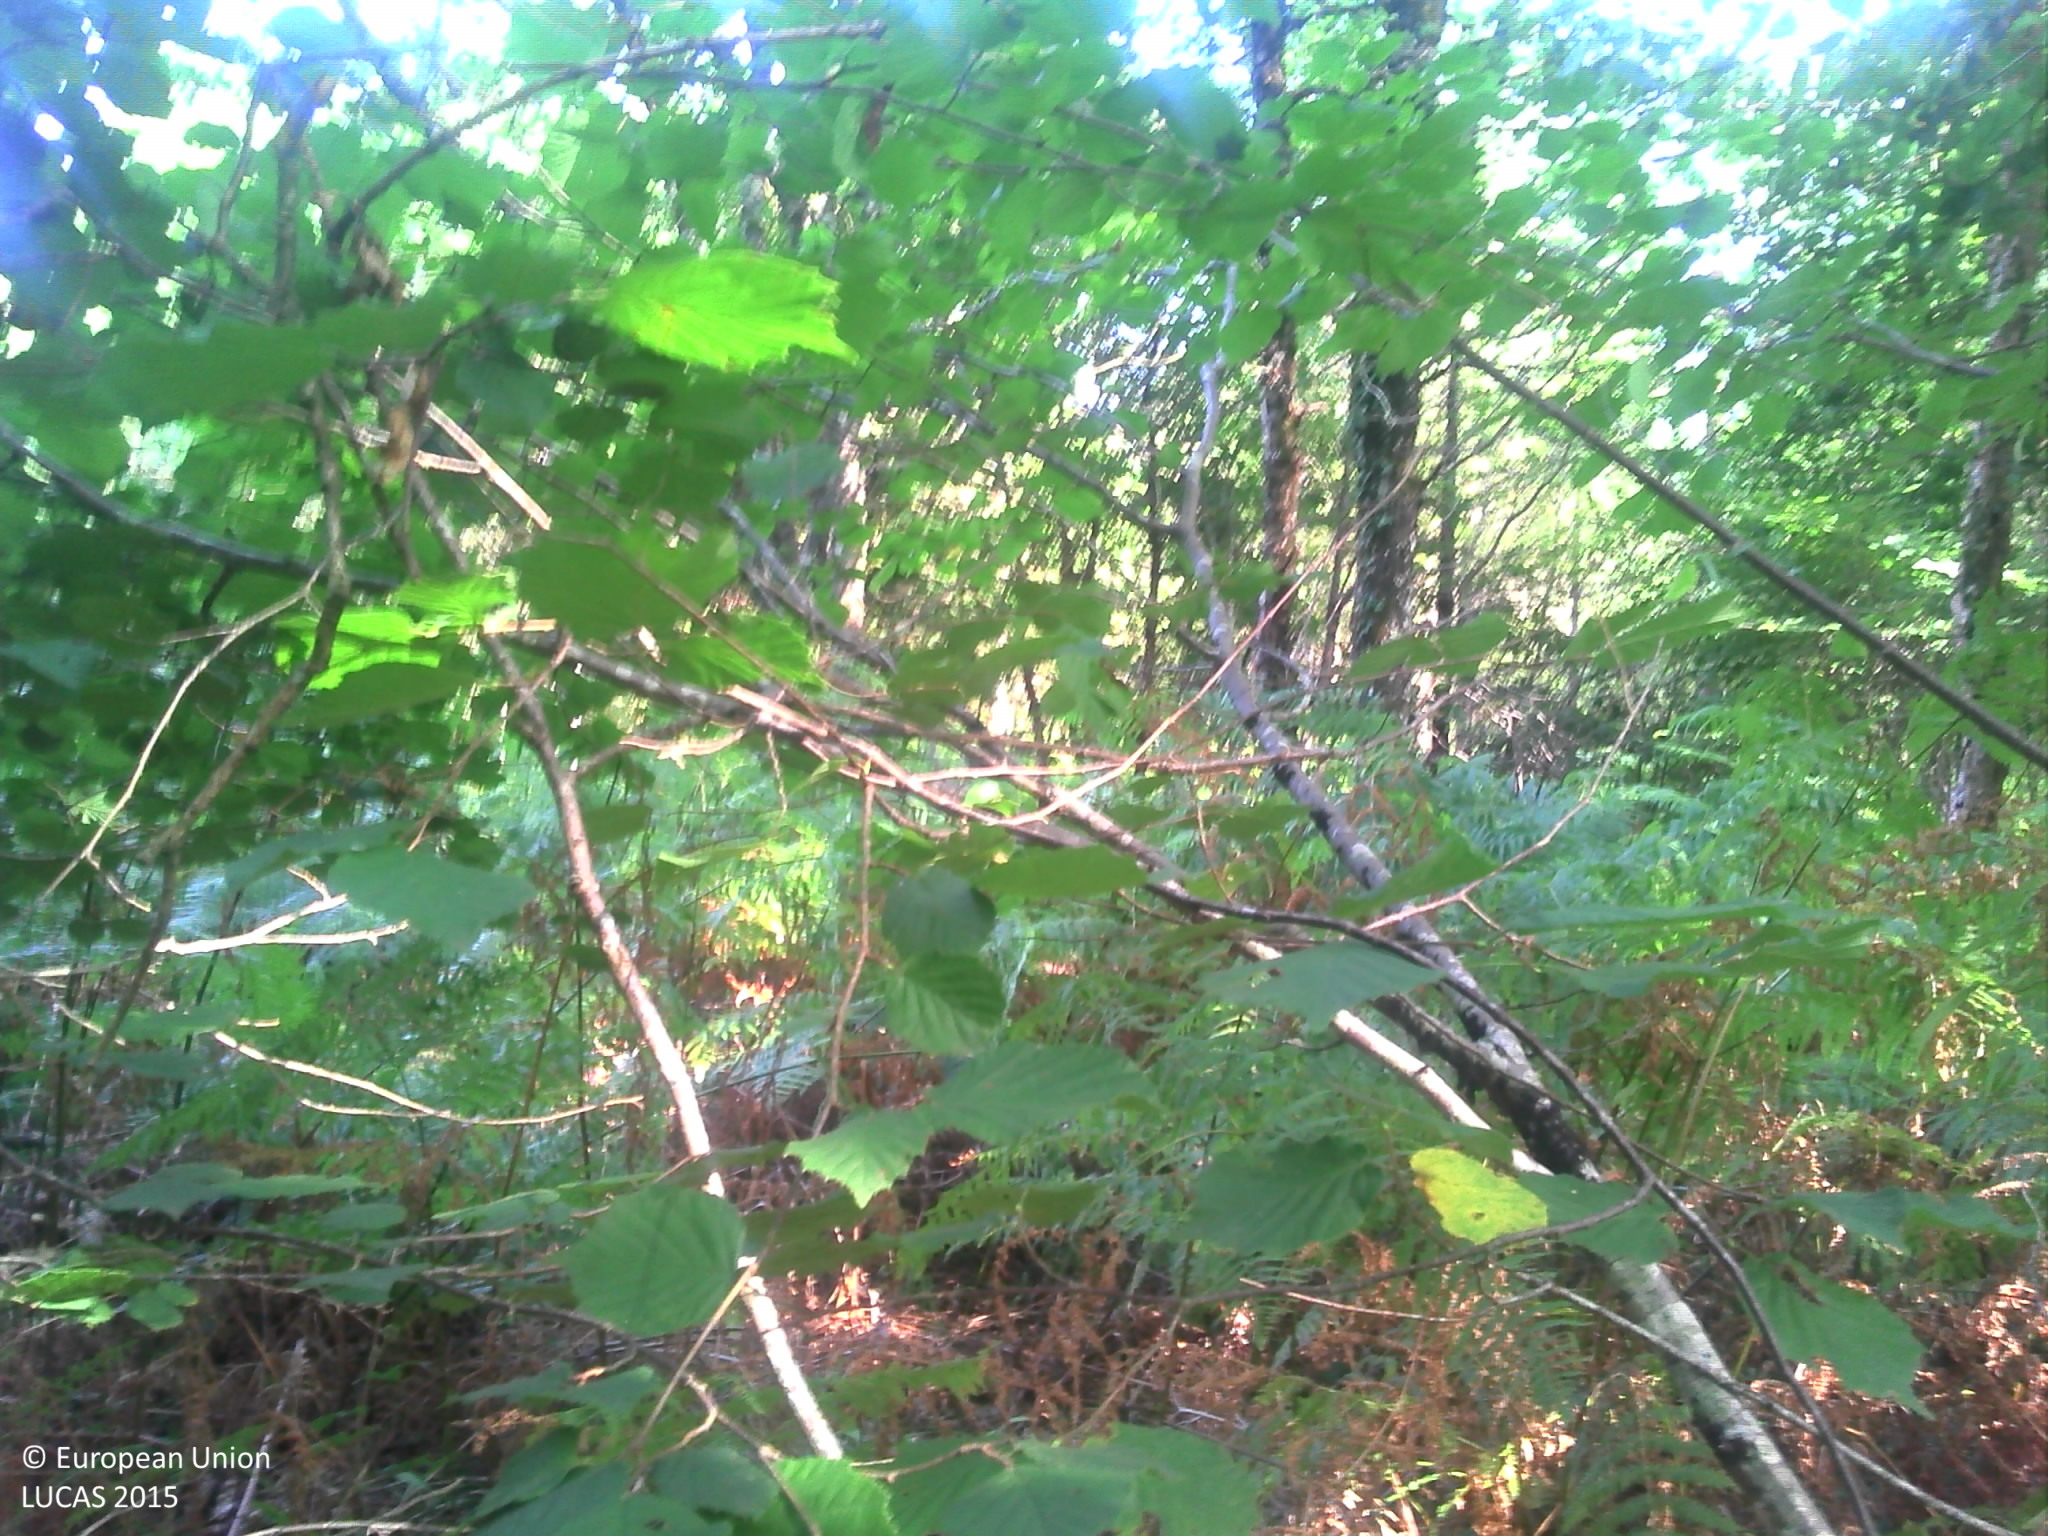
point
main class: Woodland
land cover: Broadleaved woodland
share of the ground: > 75 %
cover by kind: broadleaved forest trees 95 %, coniferous forest trees 5 %
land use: Semi-natural and natural areas not in use
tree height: > 5 m
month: August
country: FR
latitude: 46.0978
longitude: 0.9980
